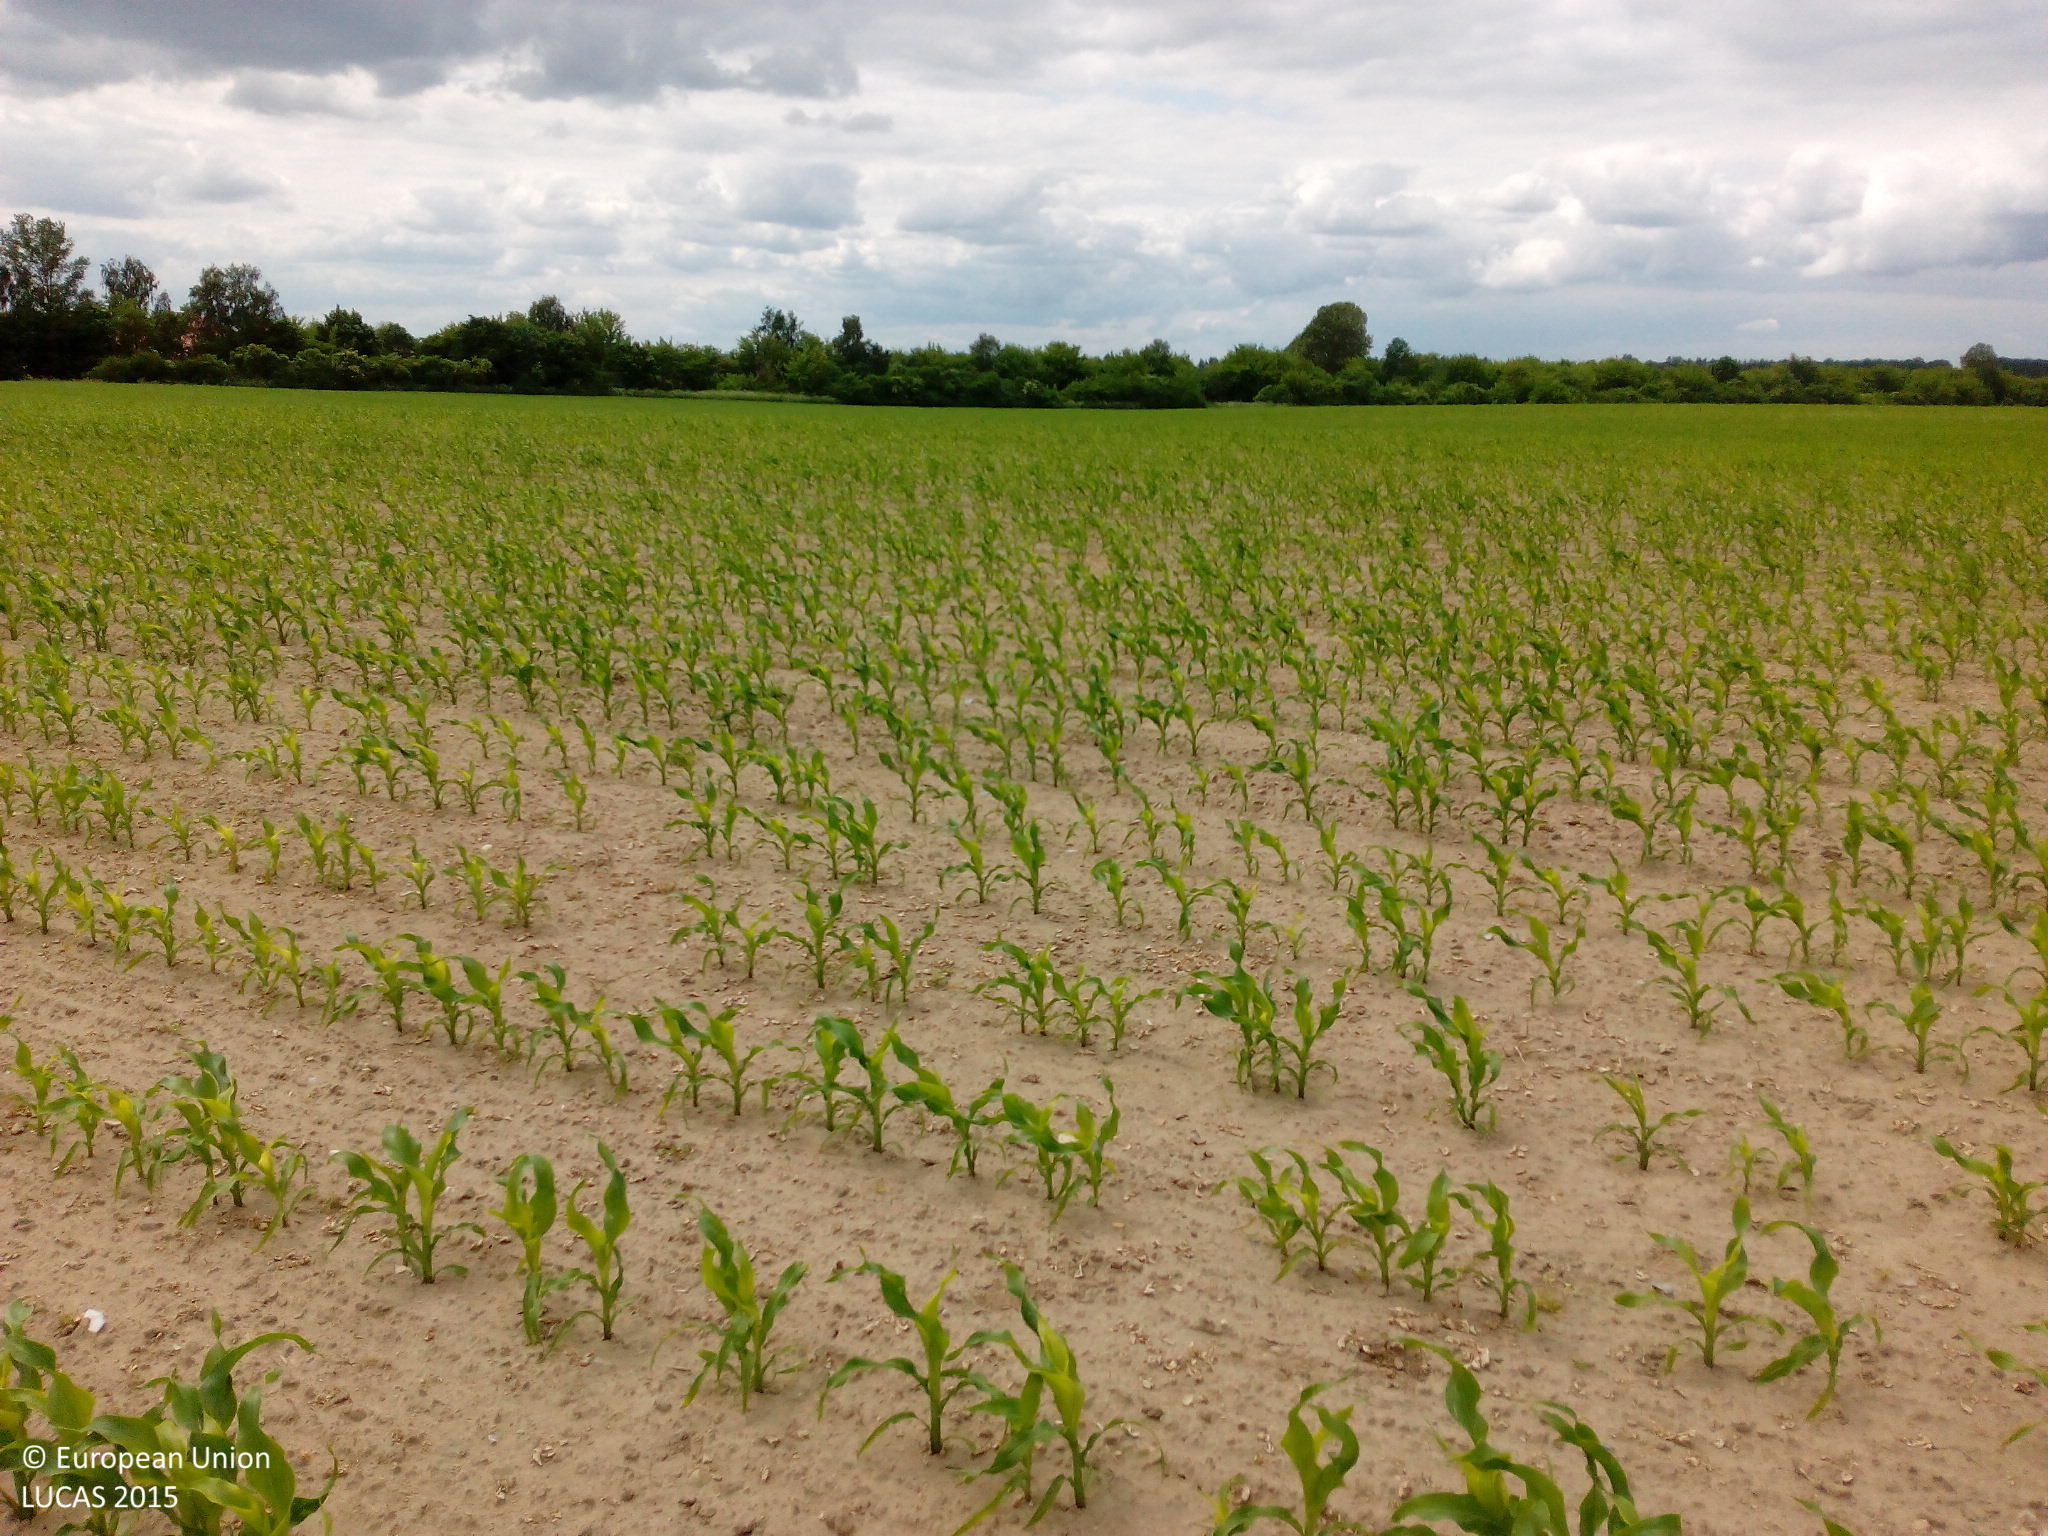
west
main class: Cropland
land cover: Maize
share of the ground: < 10 %
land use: Agriculture (excluding fallow land and kitchen gardens)
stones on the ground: < 10 %
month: June
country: DE
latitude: 53.3610
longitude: 12.3585
